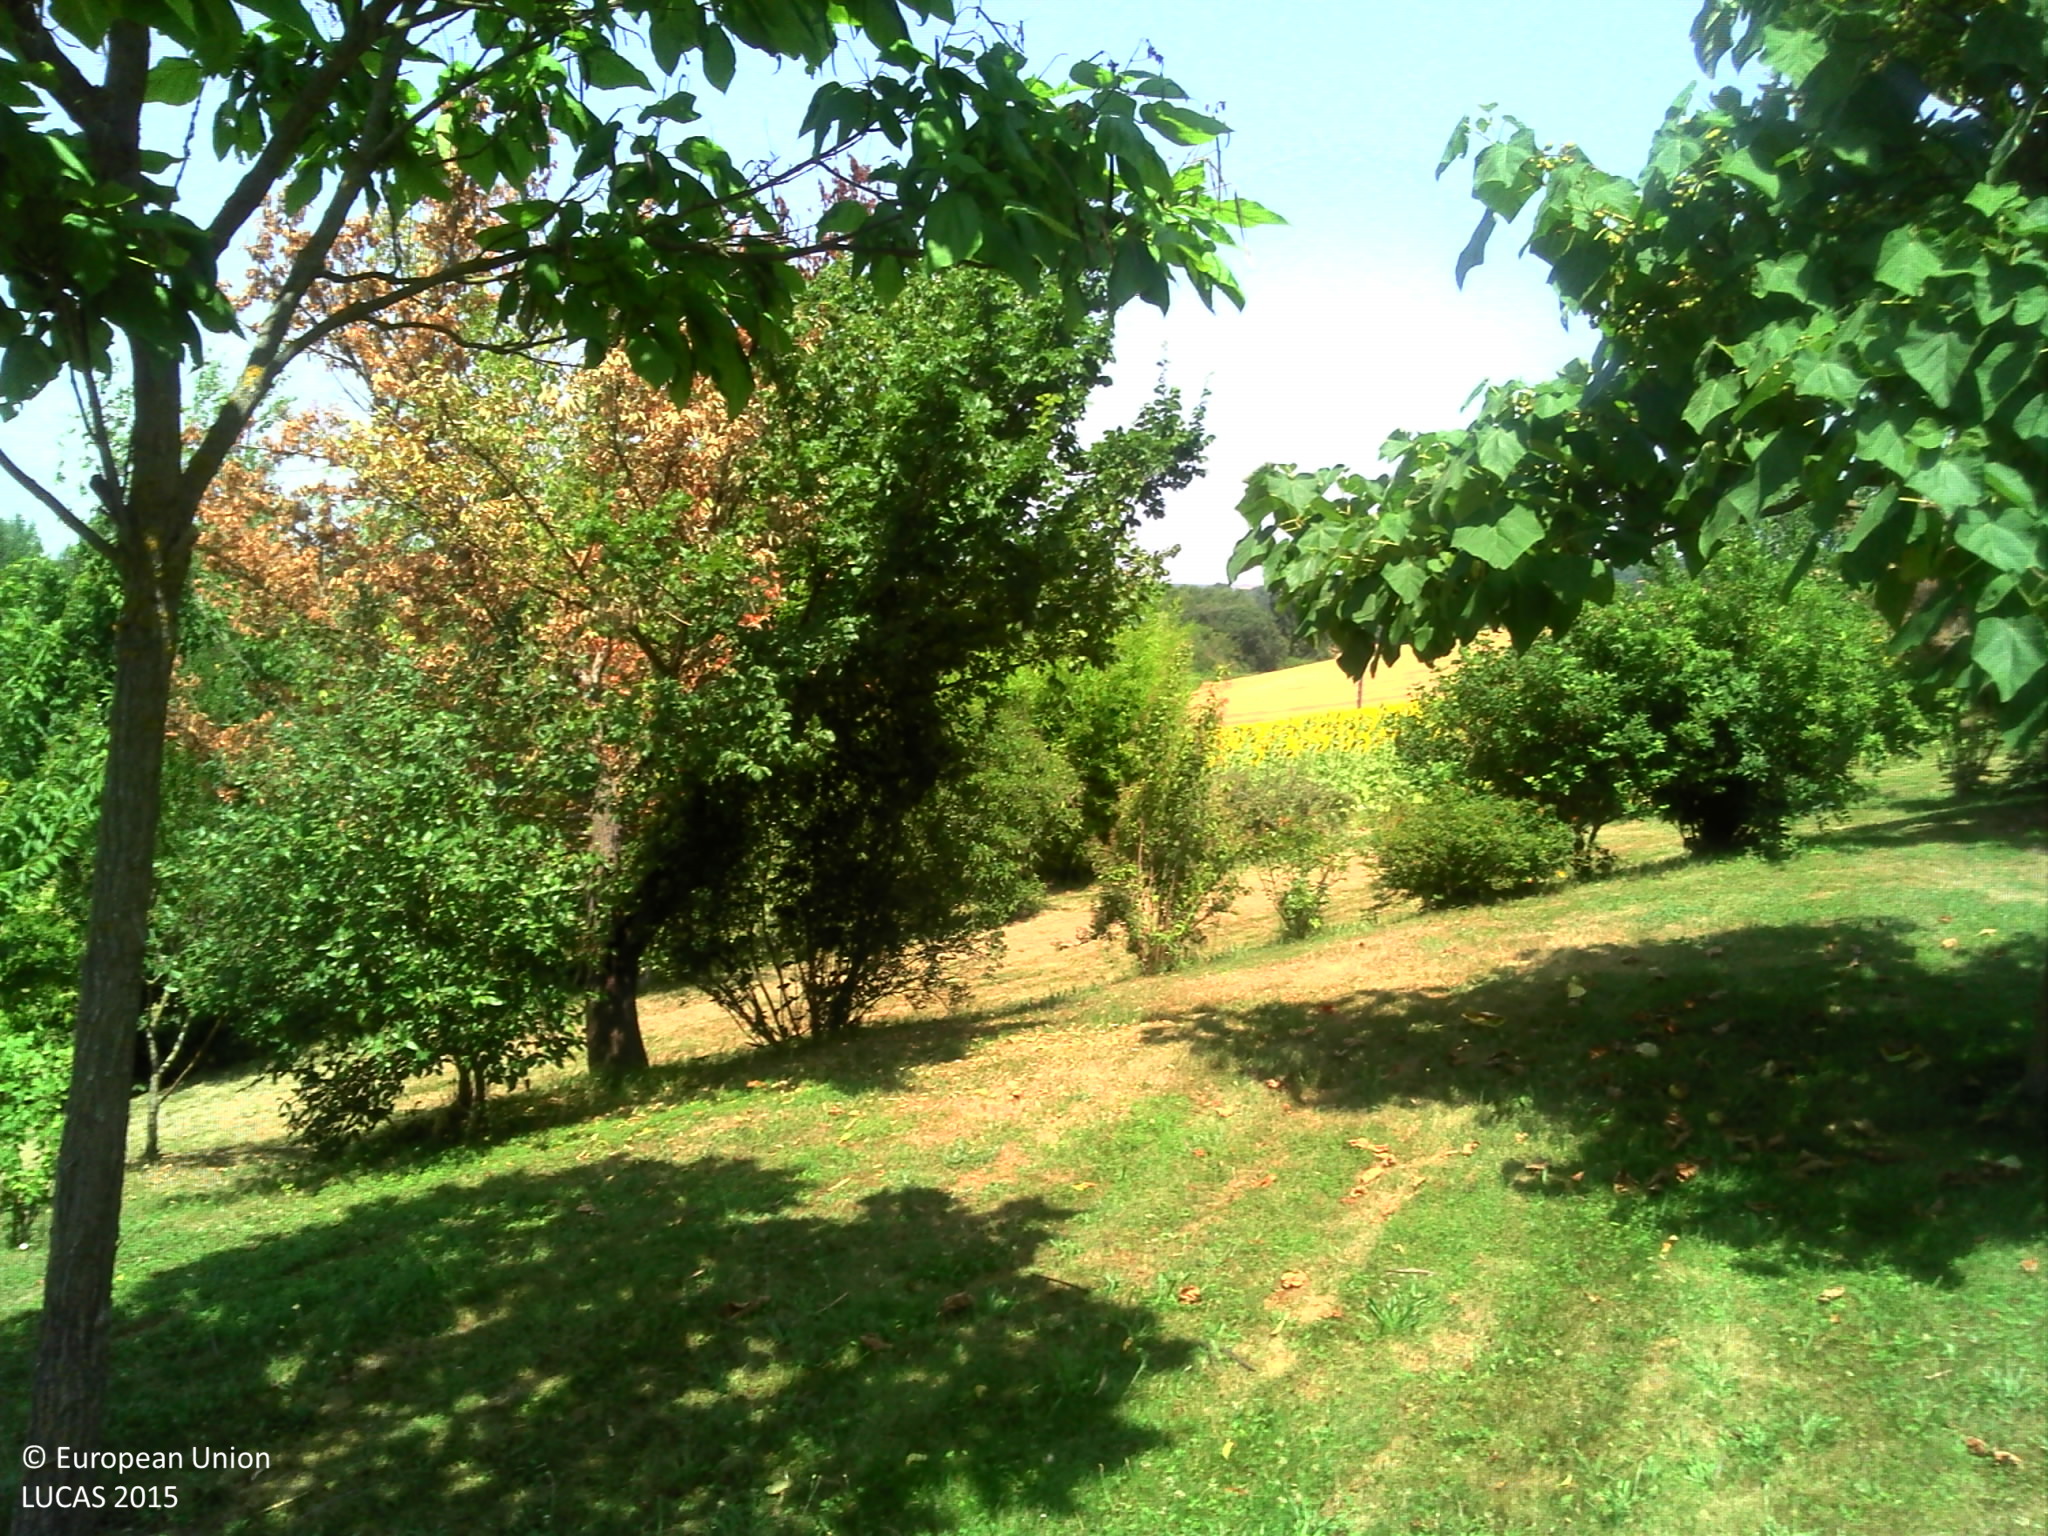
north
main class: Grassland
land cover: Grassland with sparse tree/shrub cover
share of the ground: > 75 %
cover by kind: herbaceous plants 85 %, shrubs 10 %, broadleaved forest trees 5 %
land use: Residential
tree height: < 5 m
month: July
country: FR
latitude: 43.4838
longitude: 0.9626
